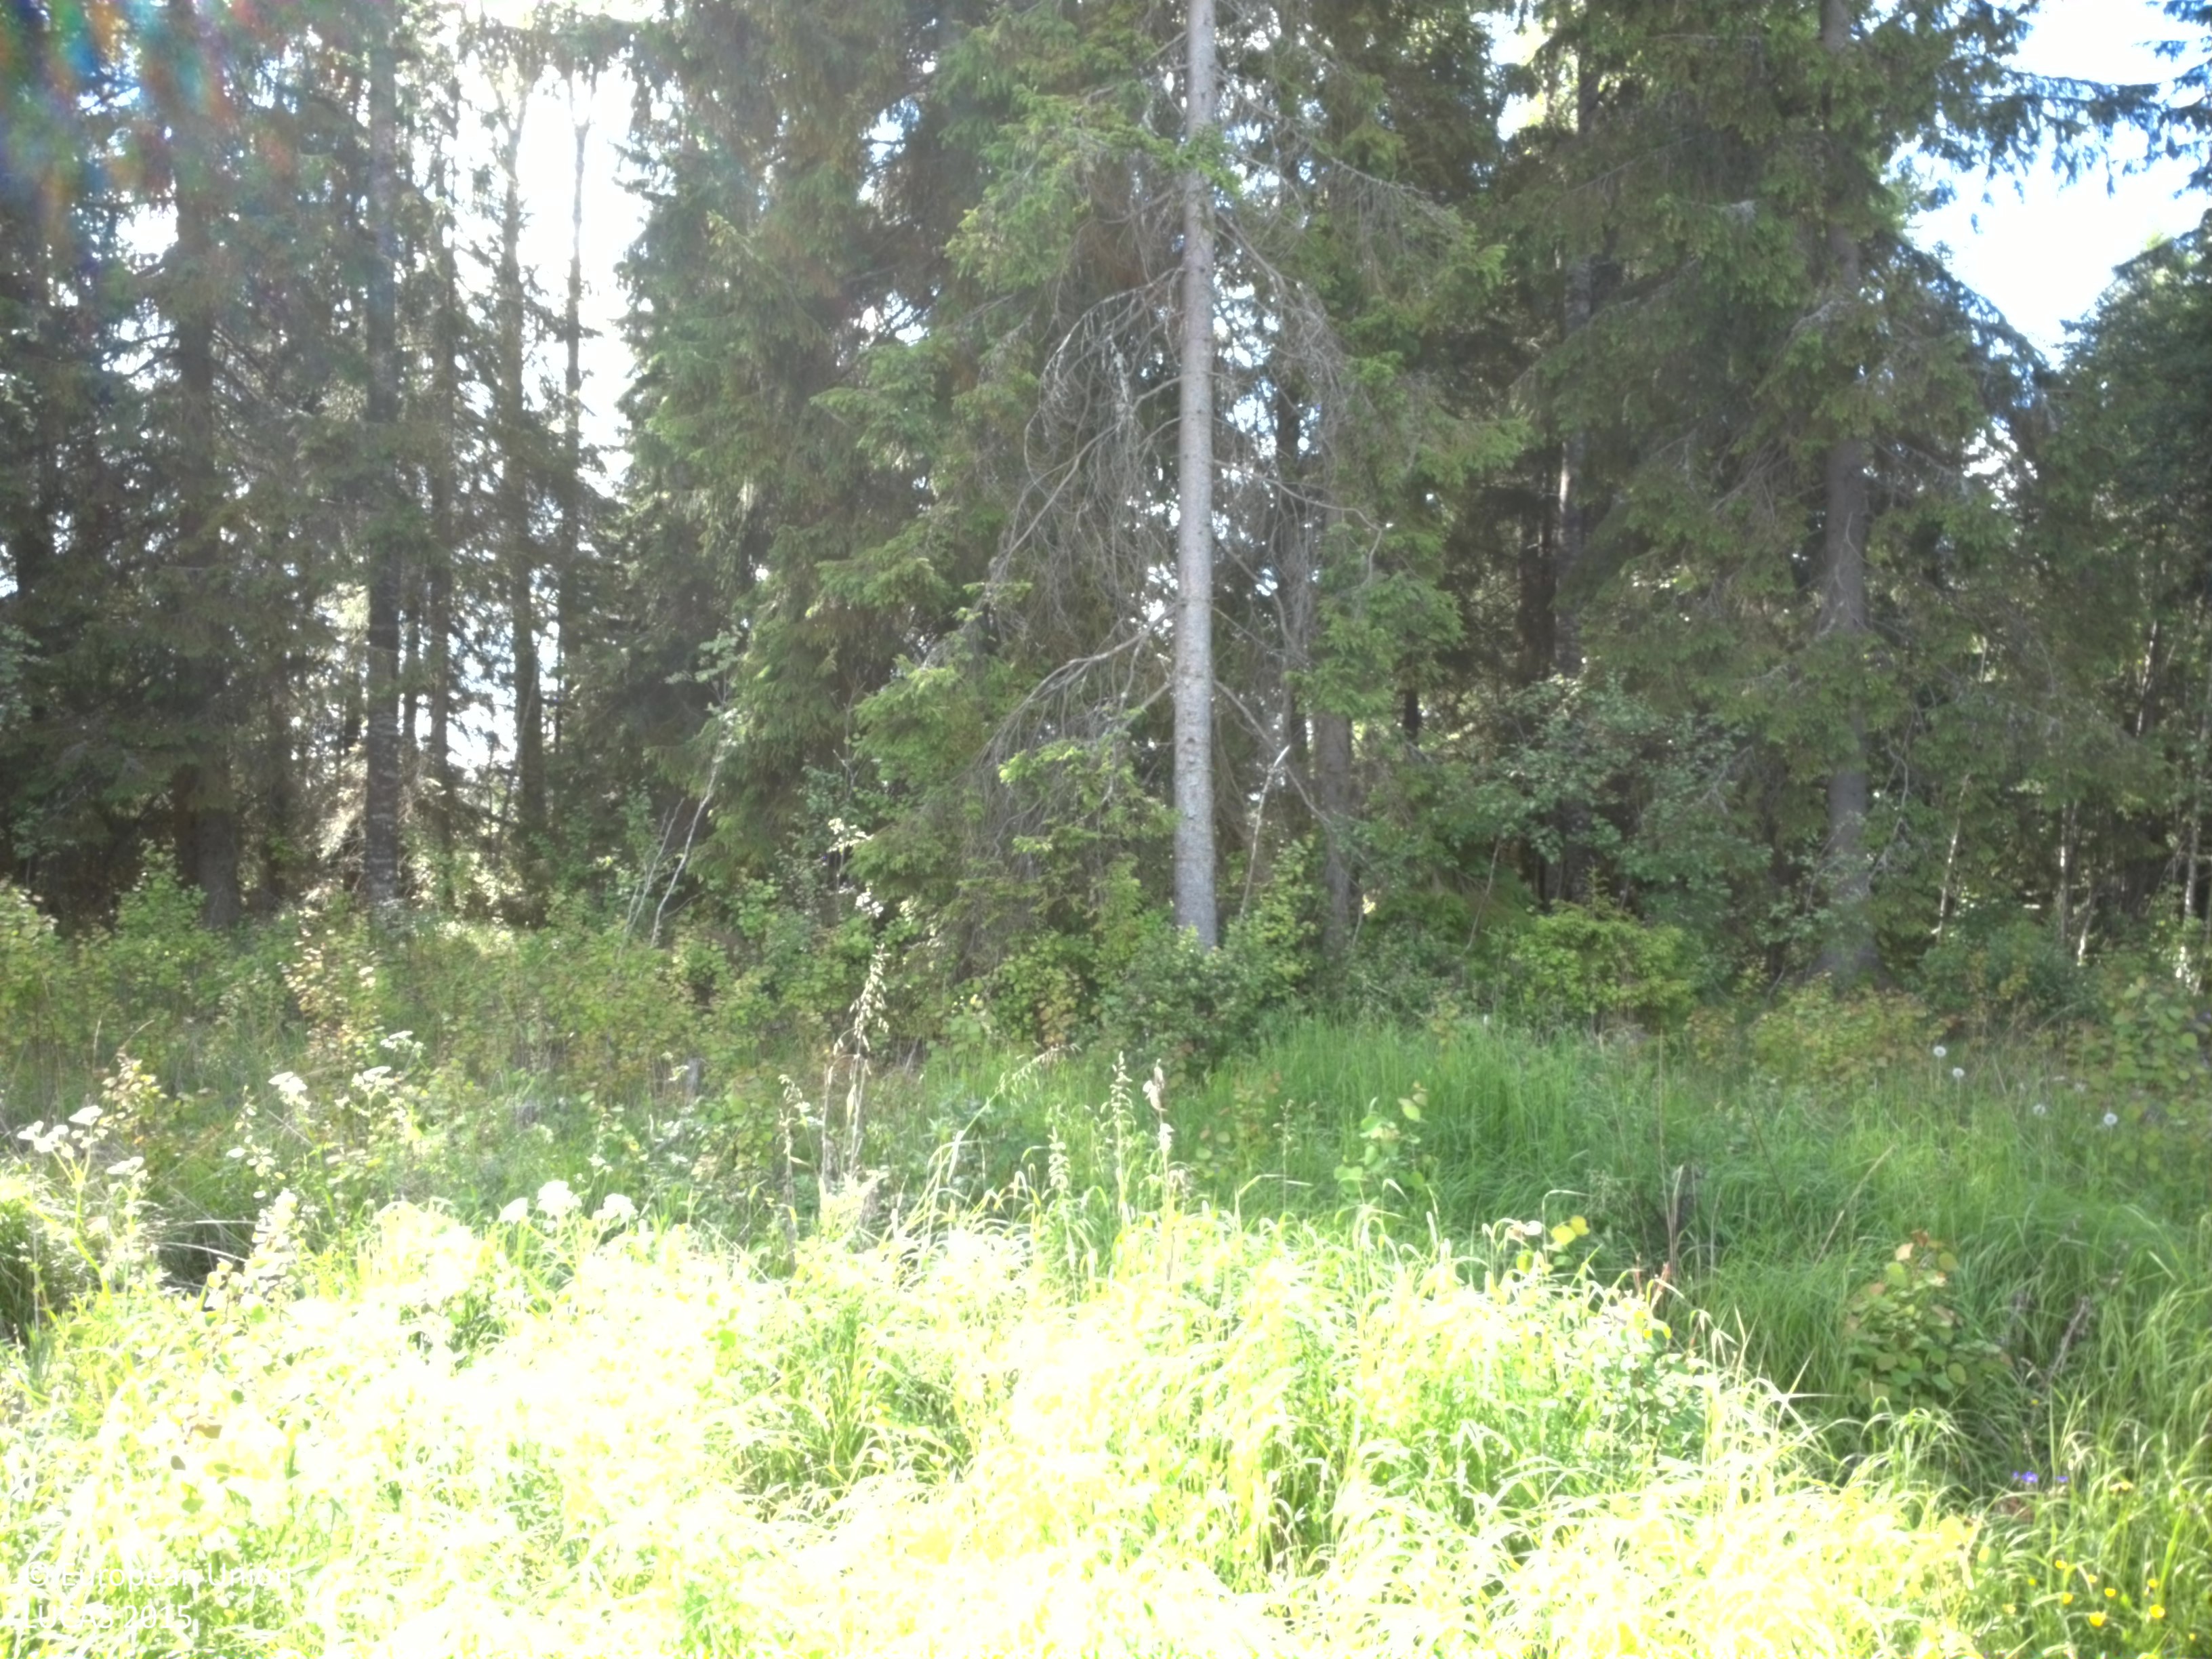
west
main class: Grassland
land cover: Grassland with sparse tree/shrub cover
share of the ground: < 10 %
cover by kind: herbaceous plants 80 %, unconsolidated bare surface 15 %, broadleaved forest trees 5 %
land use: Forestry
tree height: > 5 m
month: June
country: SE
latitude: 60.1838
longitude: 17.0770
